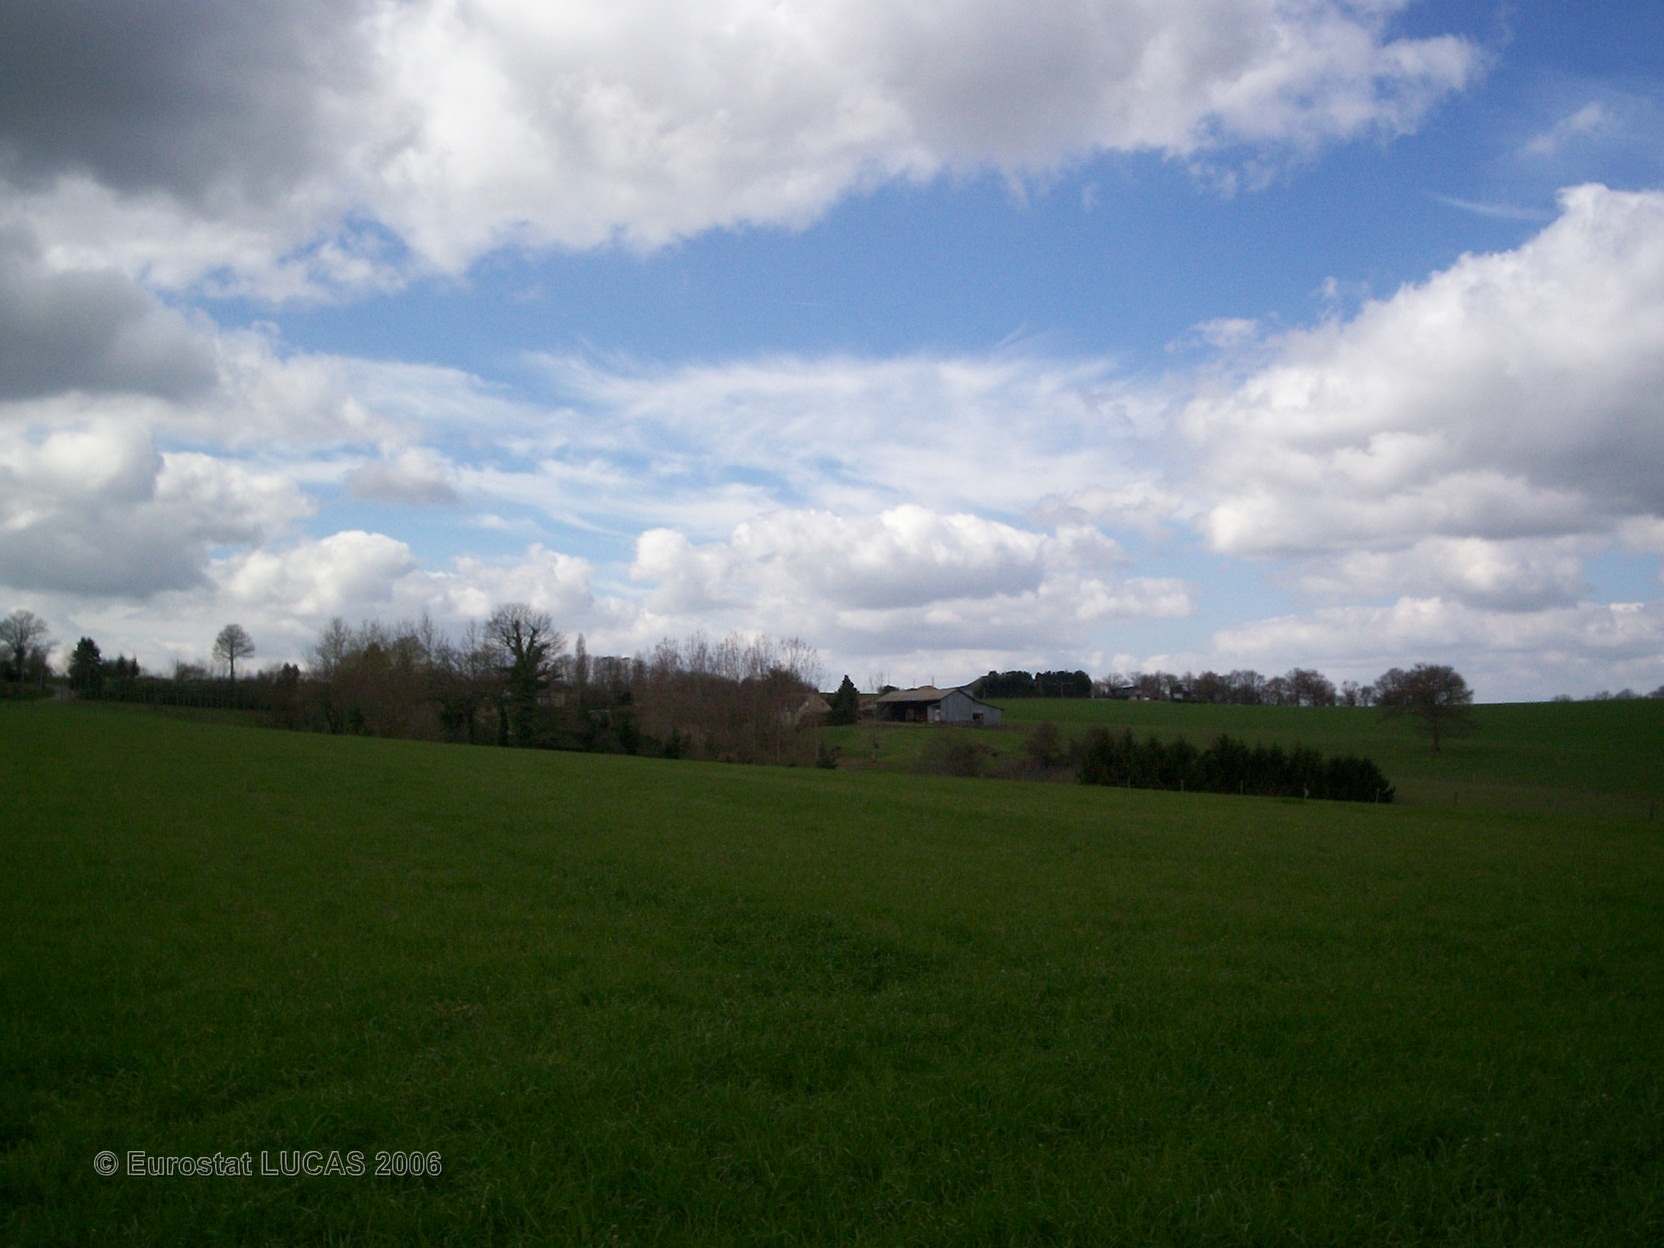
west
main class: Grassland
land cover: Grassland without tree/shrub cover
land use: Agriculture (excluding fallow land and kitchen gardens)
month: April
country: FR
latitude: 48.3054
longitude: -0.2647
